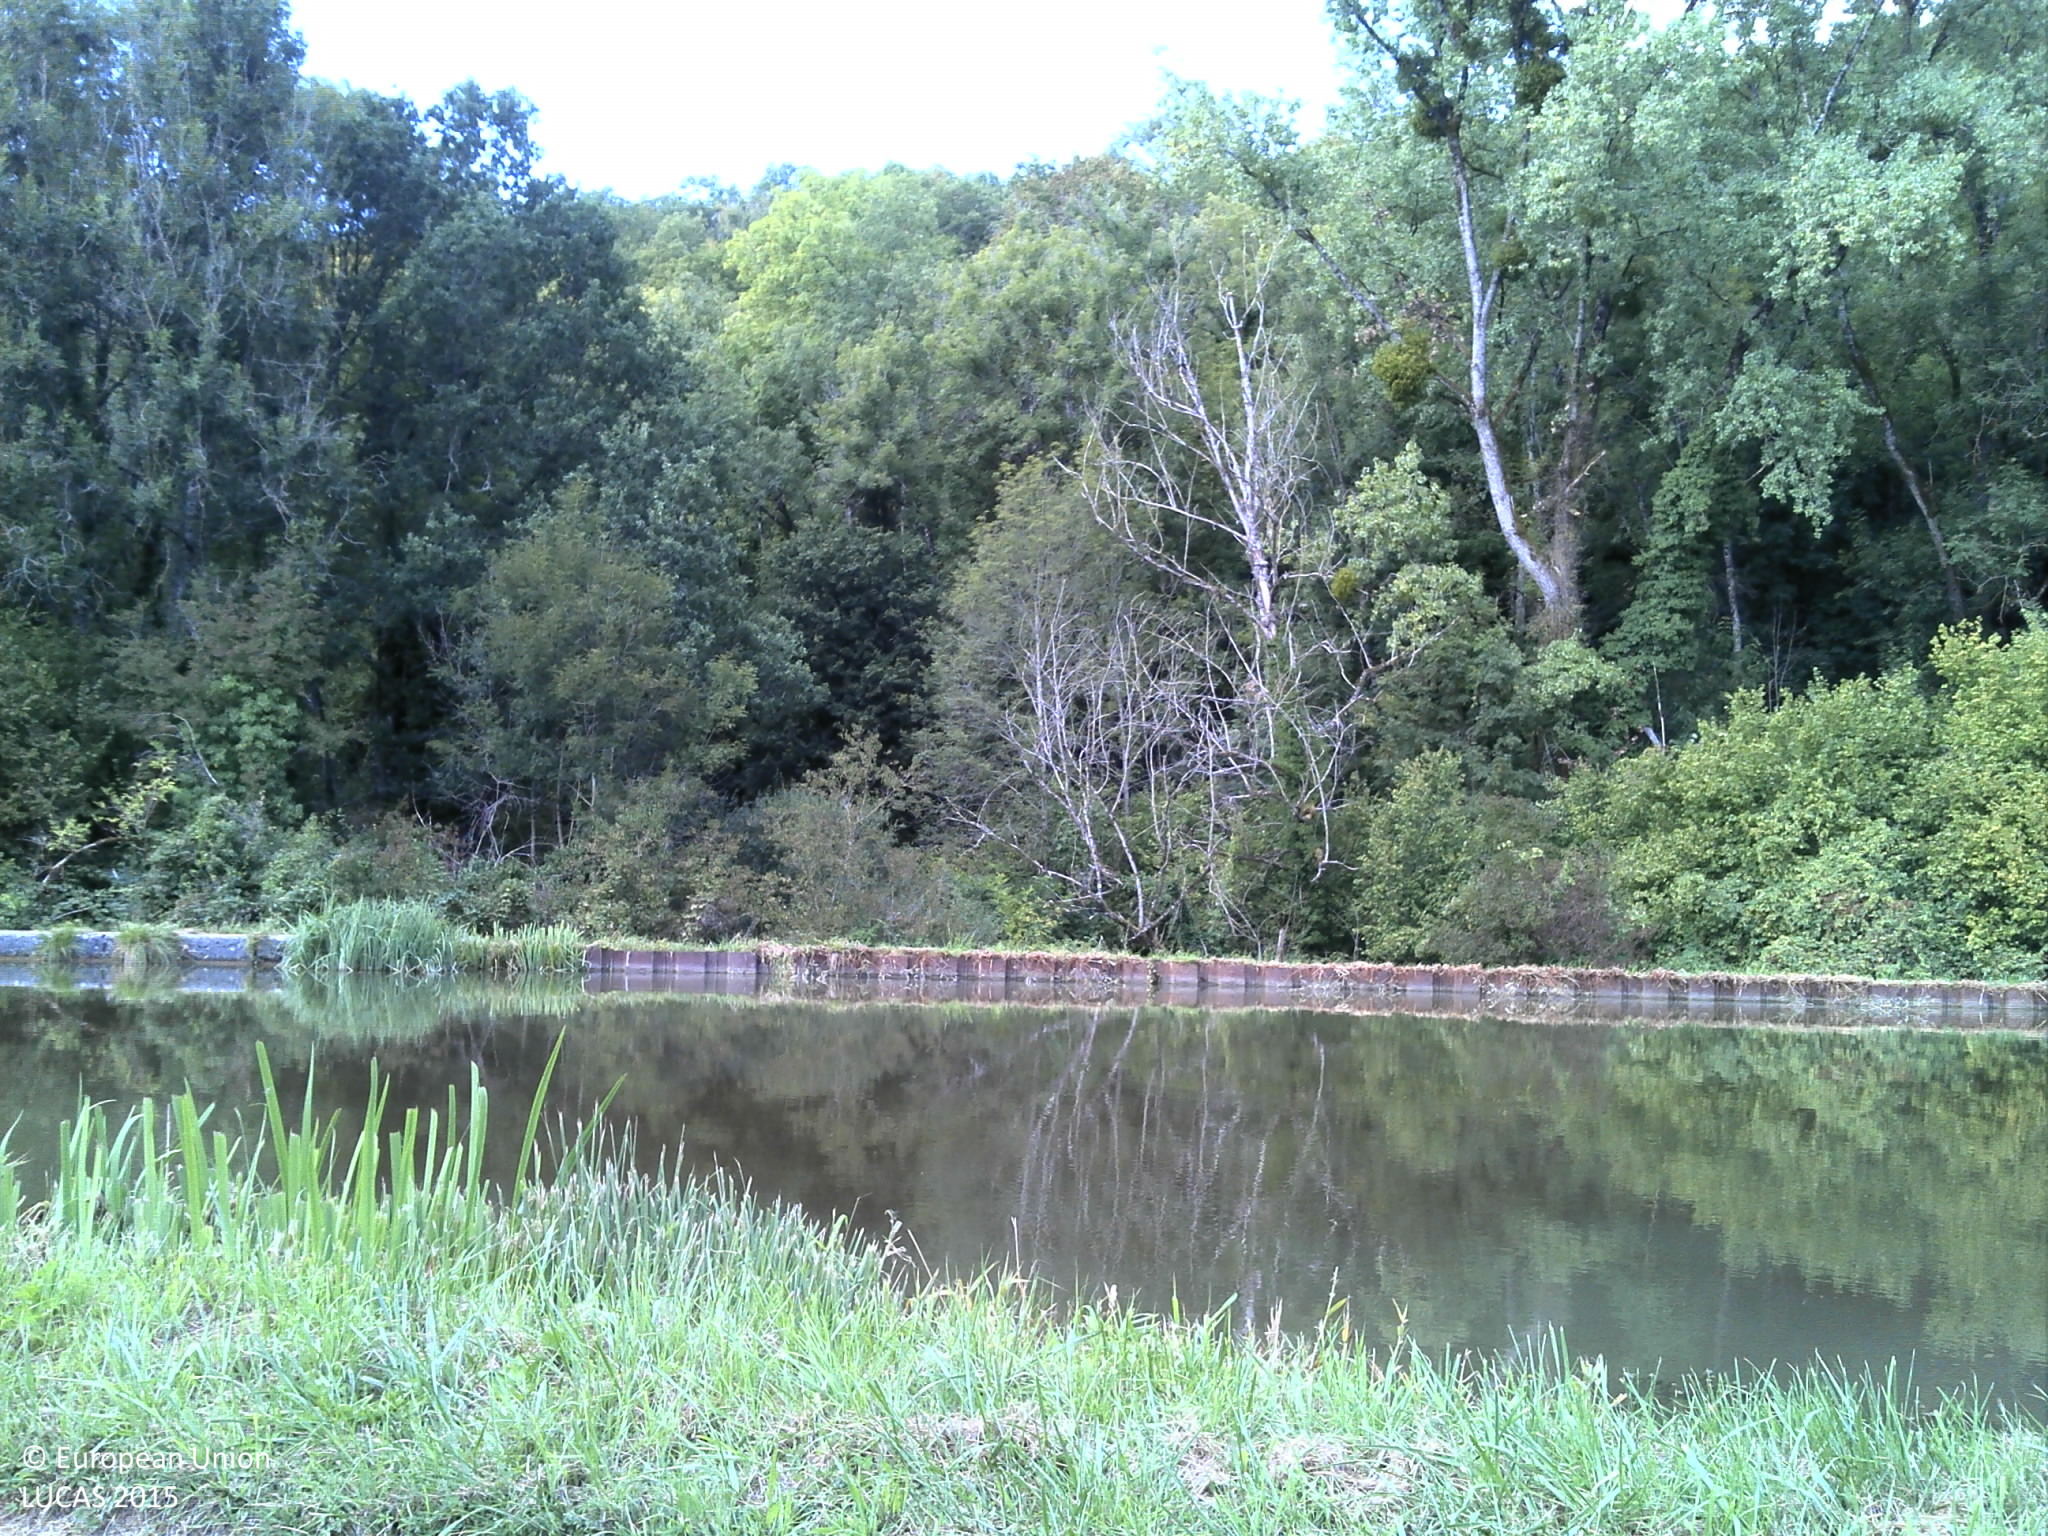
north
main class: Woodland
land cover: Broadleaved woodland
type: floodplain forest
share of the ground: 50 - 75 %
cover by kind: broadleaved forest trees 55 %, herbaceous plants 35 %, shrubs 10 %
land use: Semi-natural and natural areas not in use
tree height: > 5 m
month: September
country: FR
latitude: 48.0474
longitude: 5.2104
